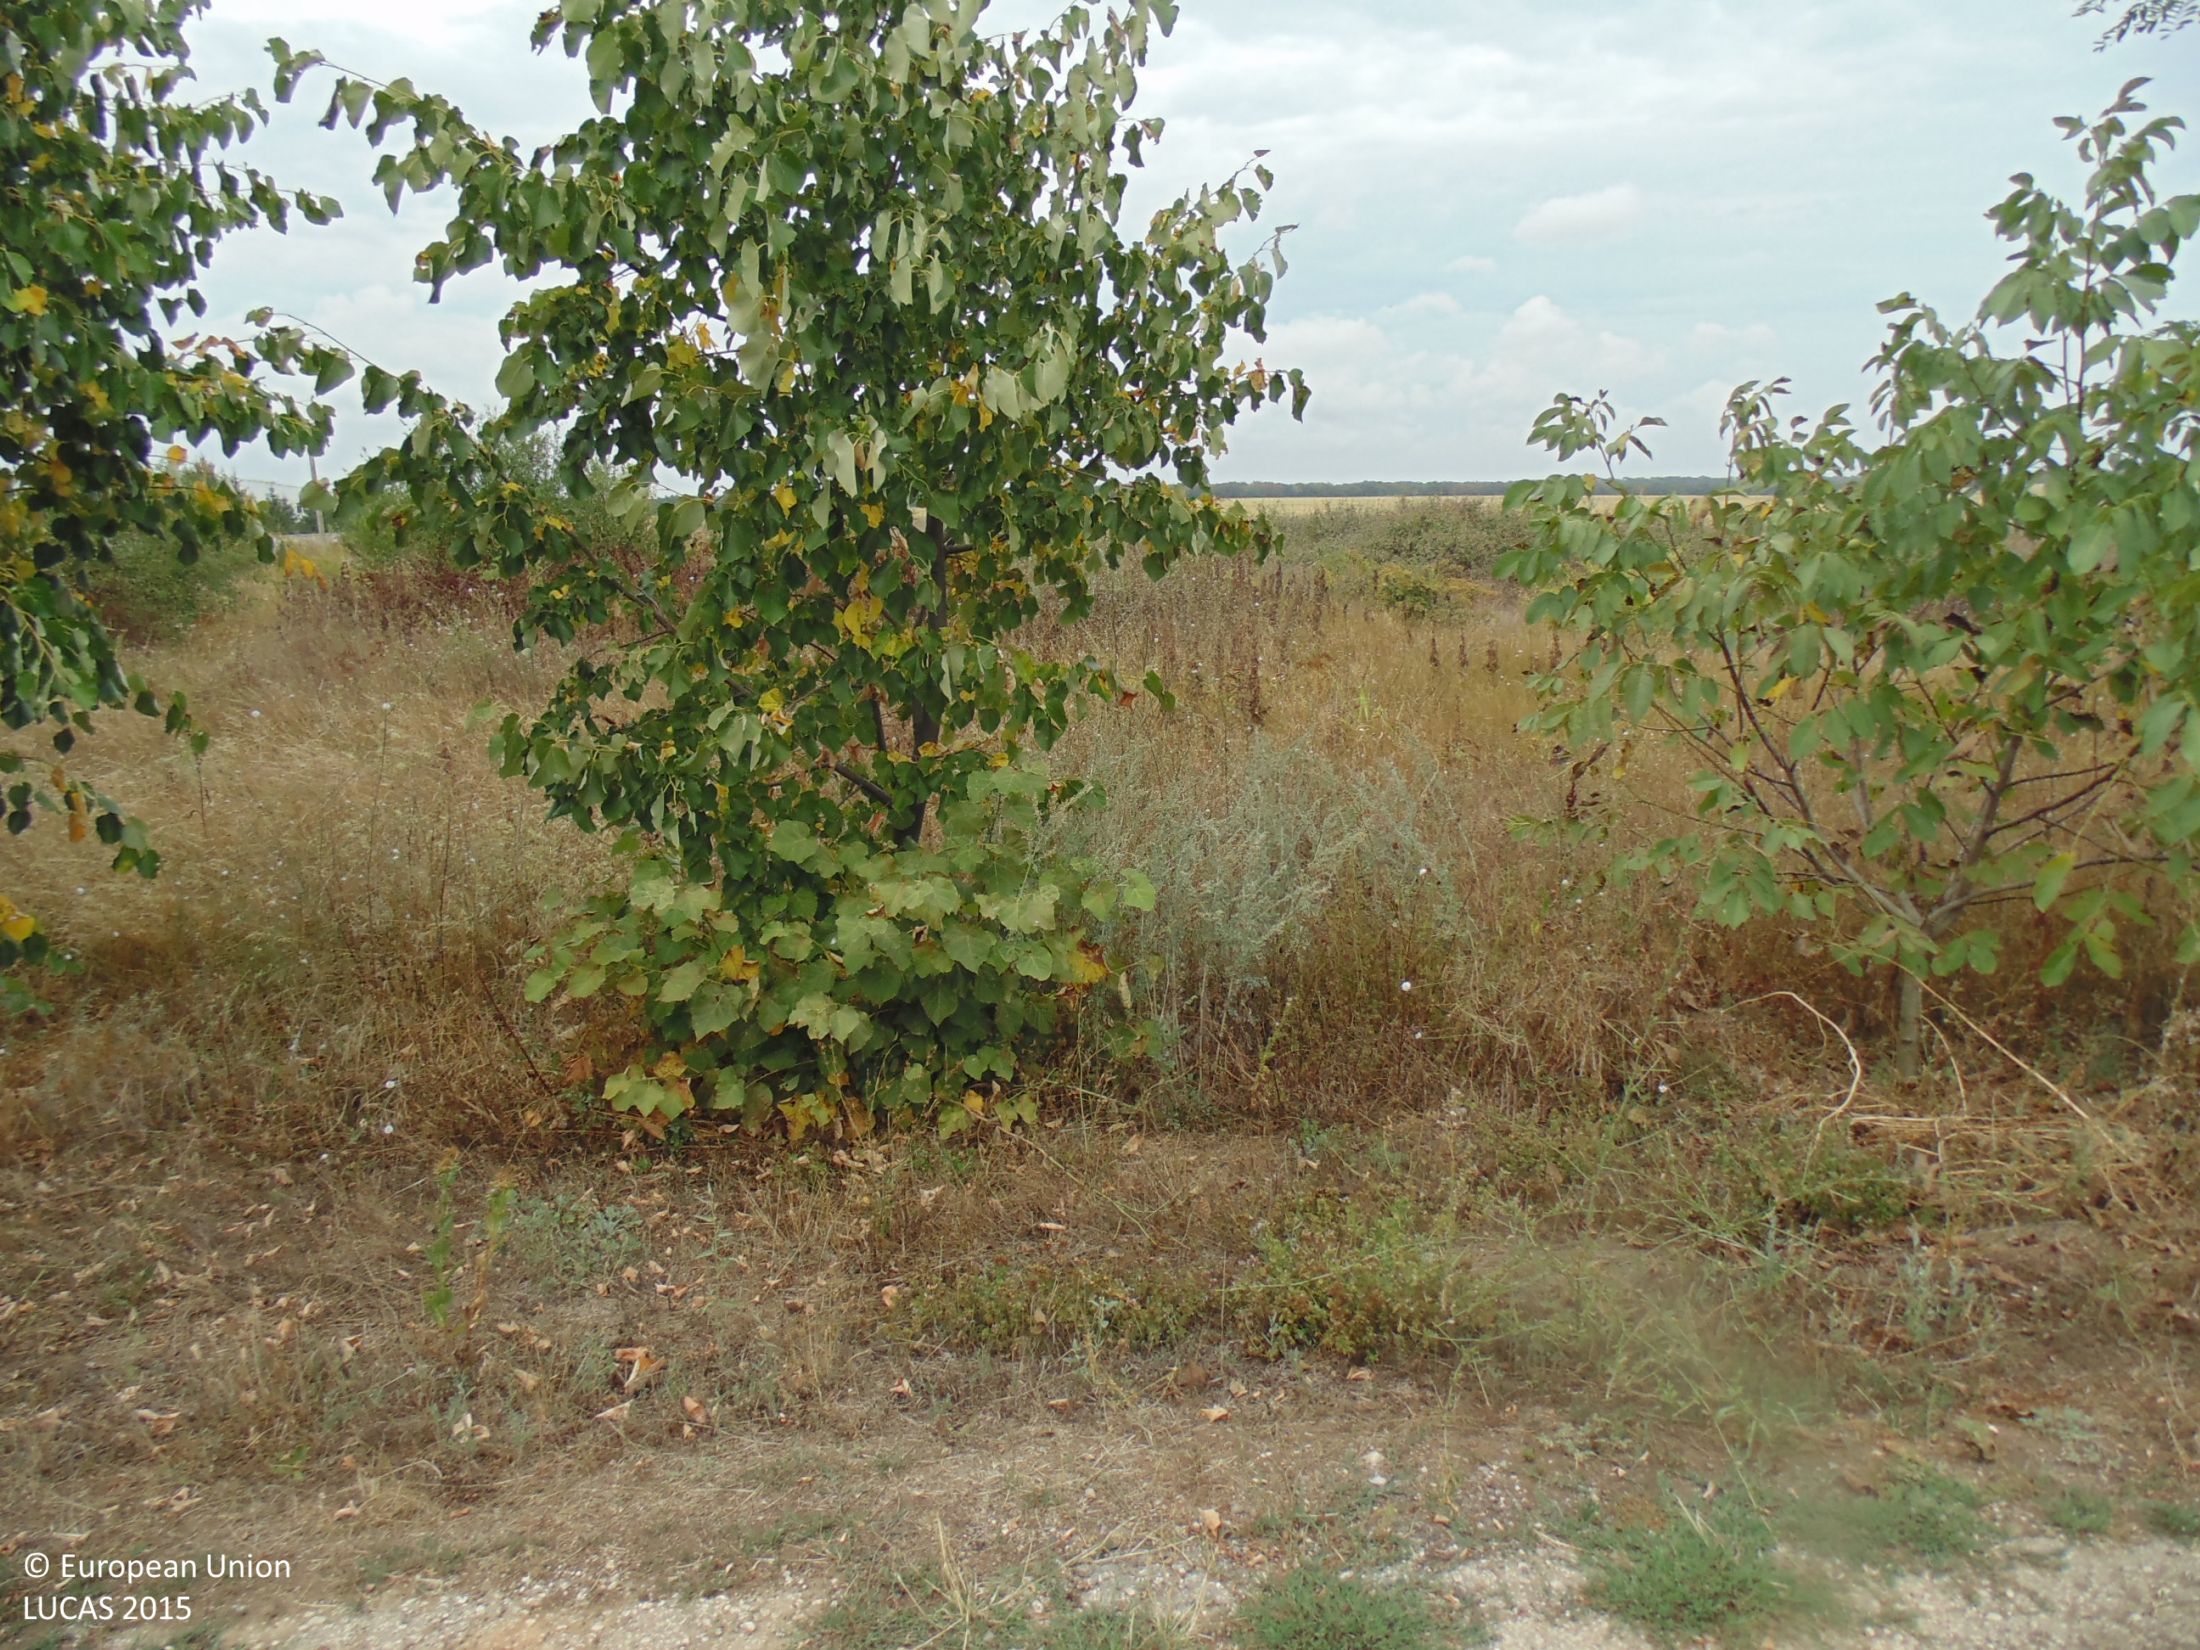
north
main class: Cropland
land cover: Apple fruit
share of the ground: > 75 %
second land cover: Spontaneously vegetated surfaces
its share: > 75 %
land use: Agriculture (excluding fallow land and kitchen gardens)
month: August
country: BG
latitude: 43.5914
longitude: 28.5064
